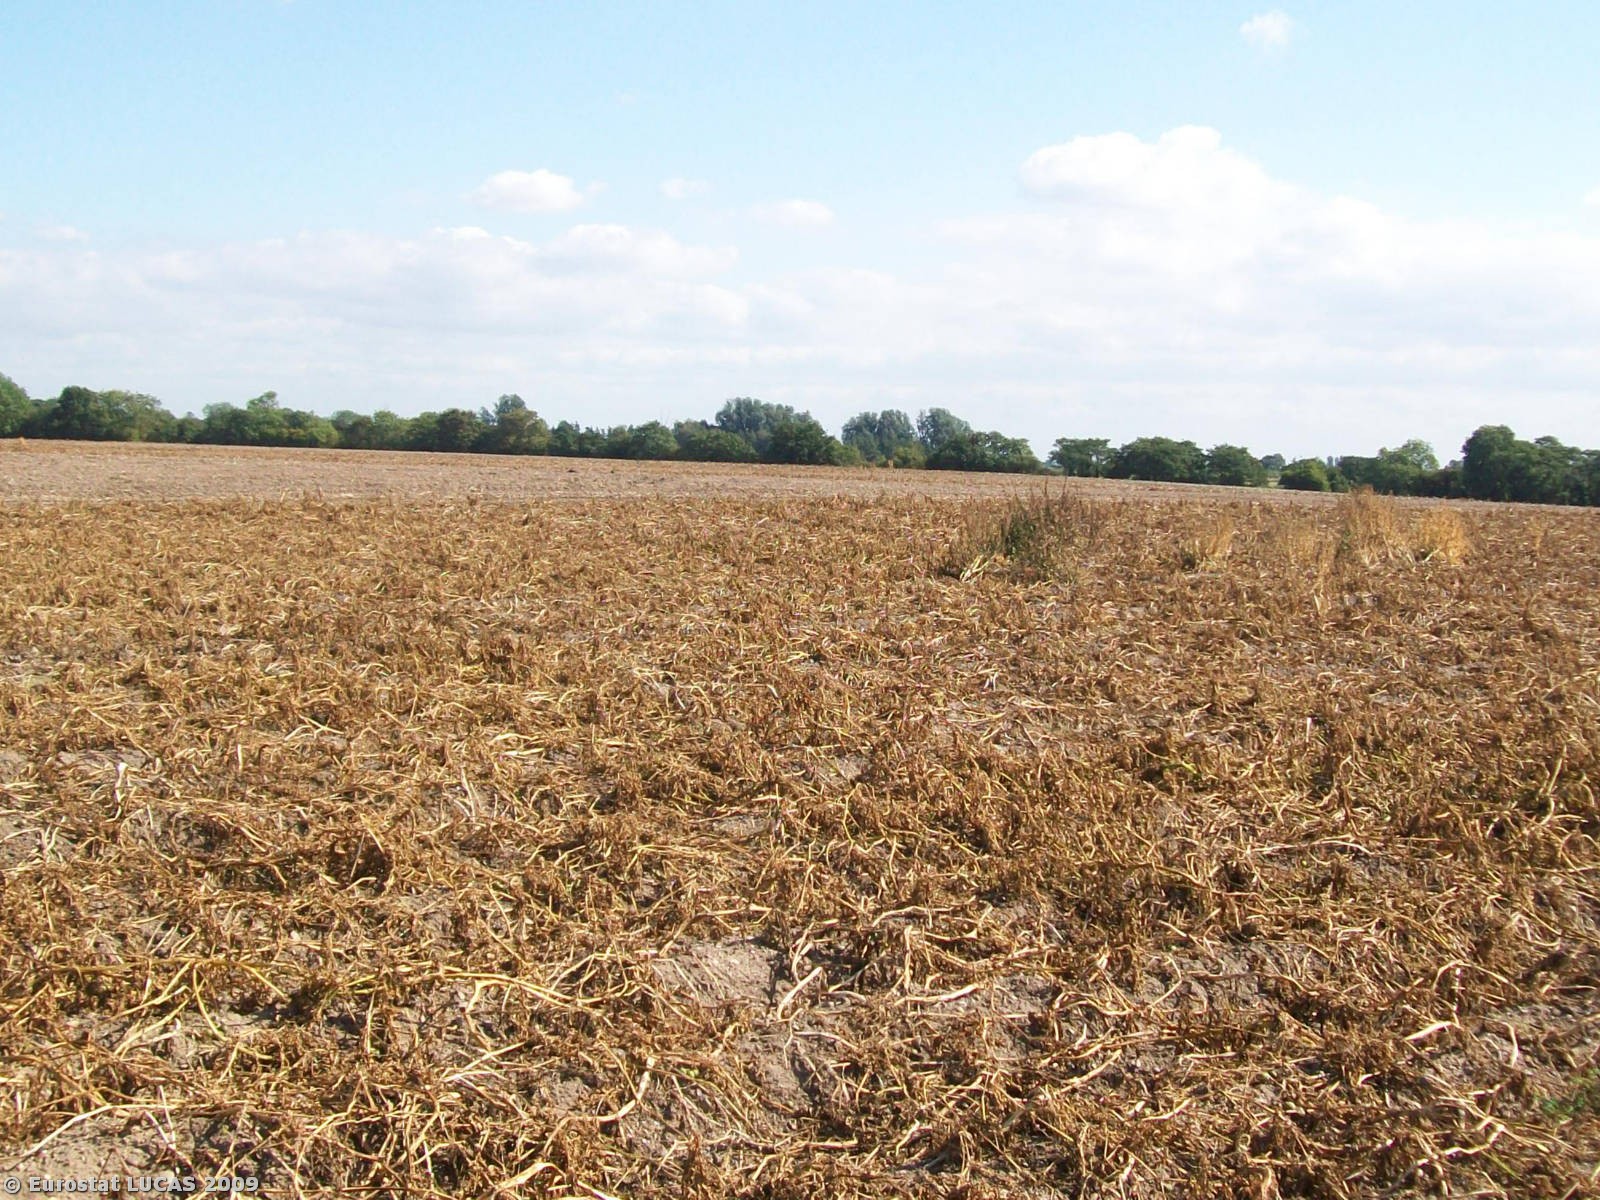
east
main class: Cropland
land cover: Potatoes
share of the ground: > 75 %
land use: Agriculture (excluding fallow land and kitchen gardens)
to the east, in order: Potatoes; Managed hedges; Lines of trees; Arable land (only in case pi)
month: September
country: GB
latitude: 52.7744
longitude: -2.6236
